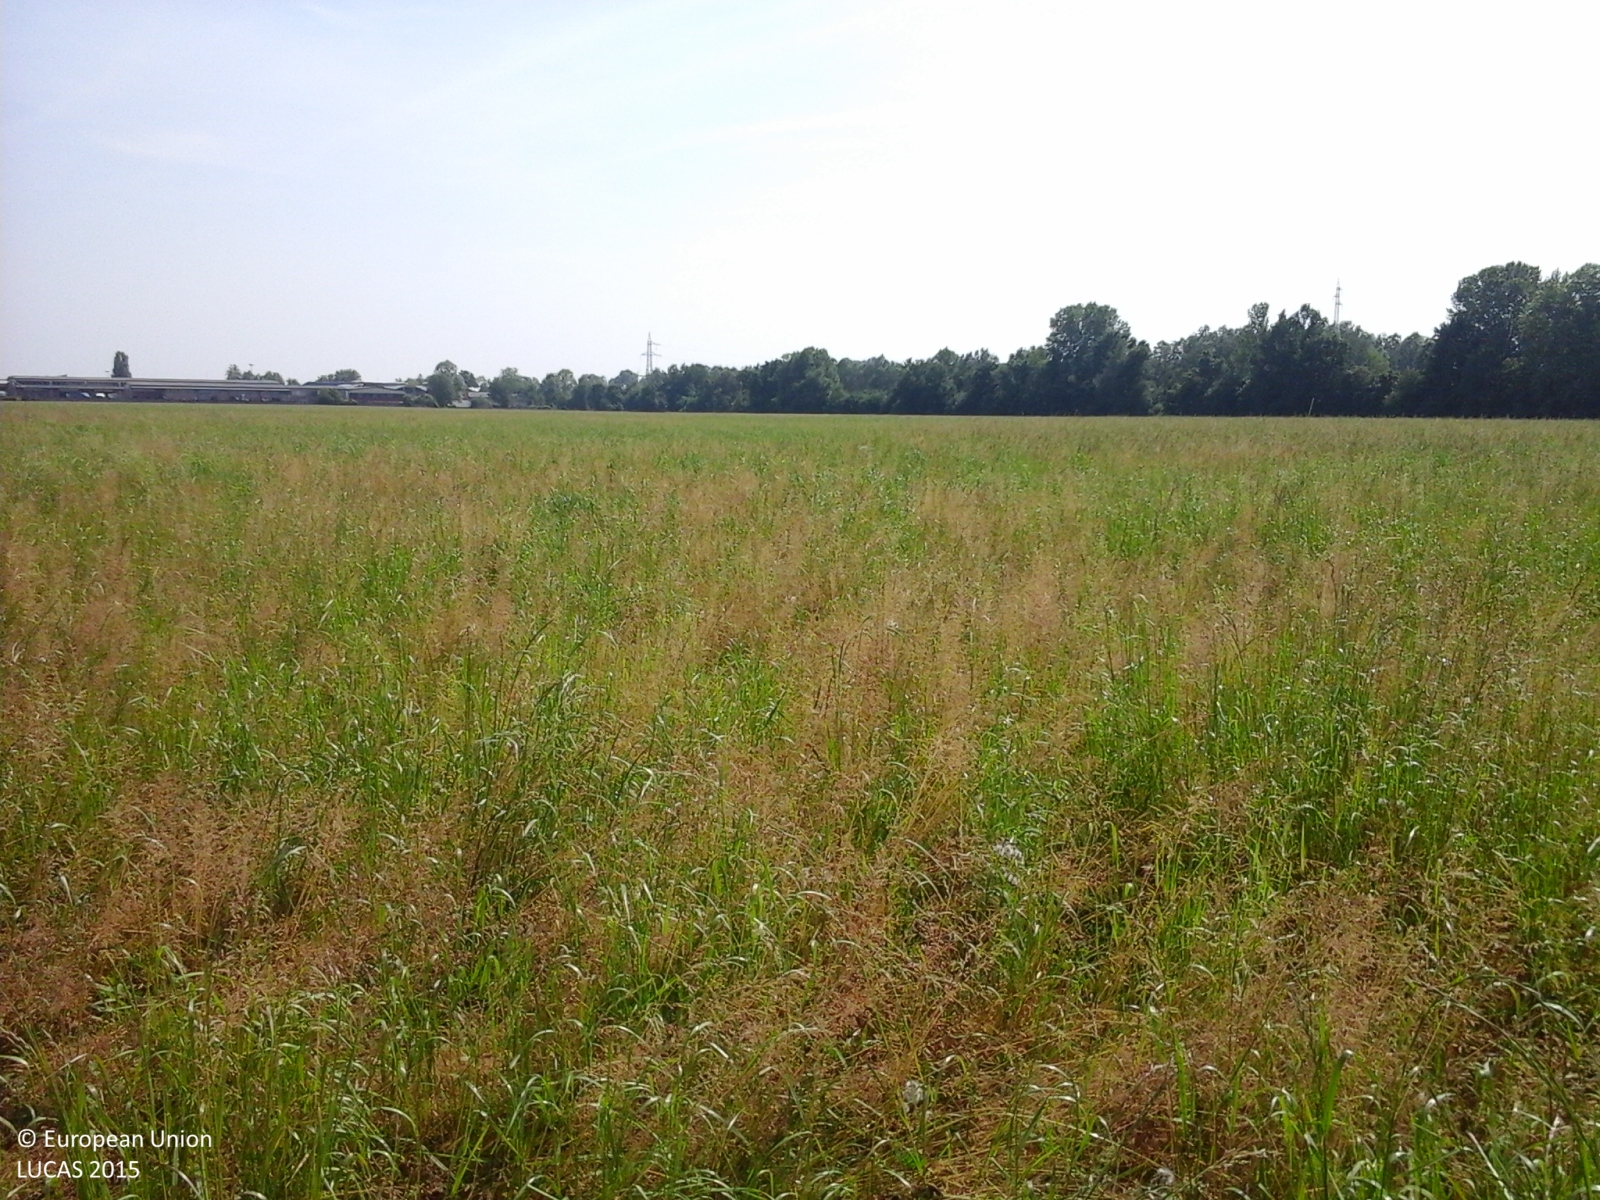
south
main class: Grassland
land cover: Spontaneously vegetated surfaces
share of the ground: > 75 %
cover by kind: herbaceous plants 100 %
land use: Agriculture (excluding fallow land and kitchen gardens)
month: May
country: IT
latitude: 45.4485
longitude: 9.3746
